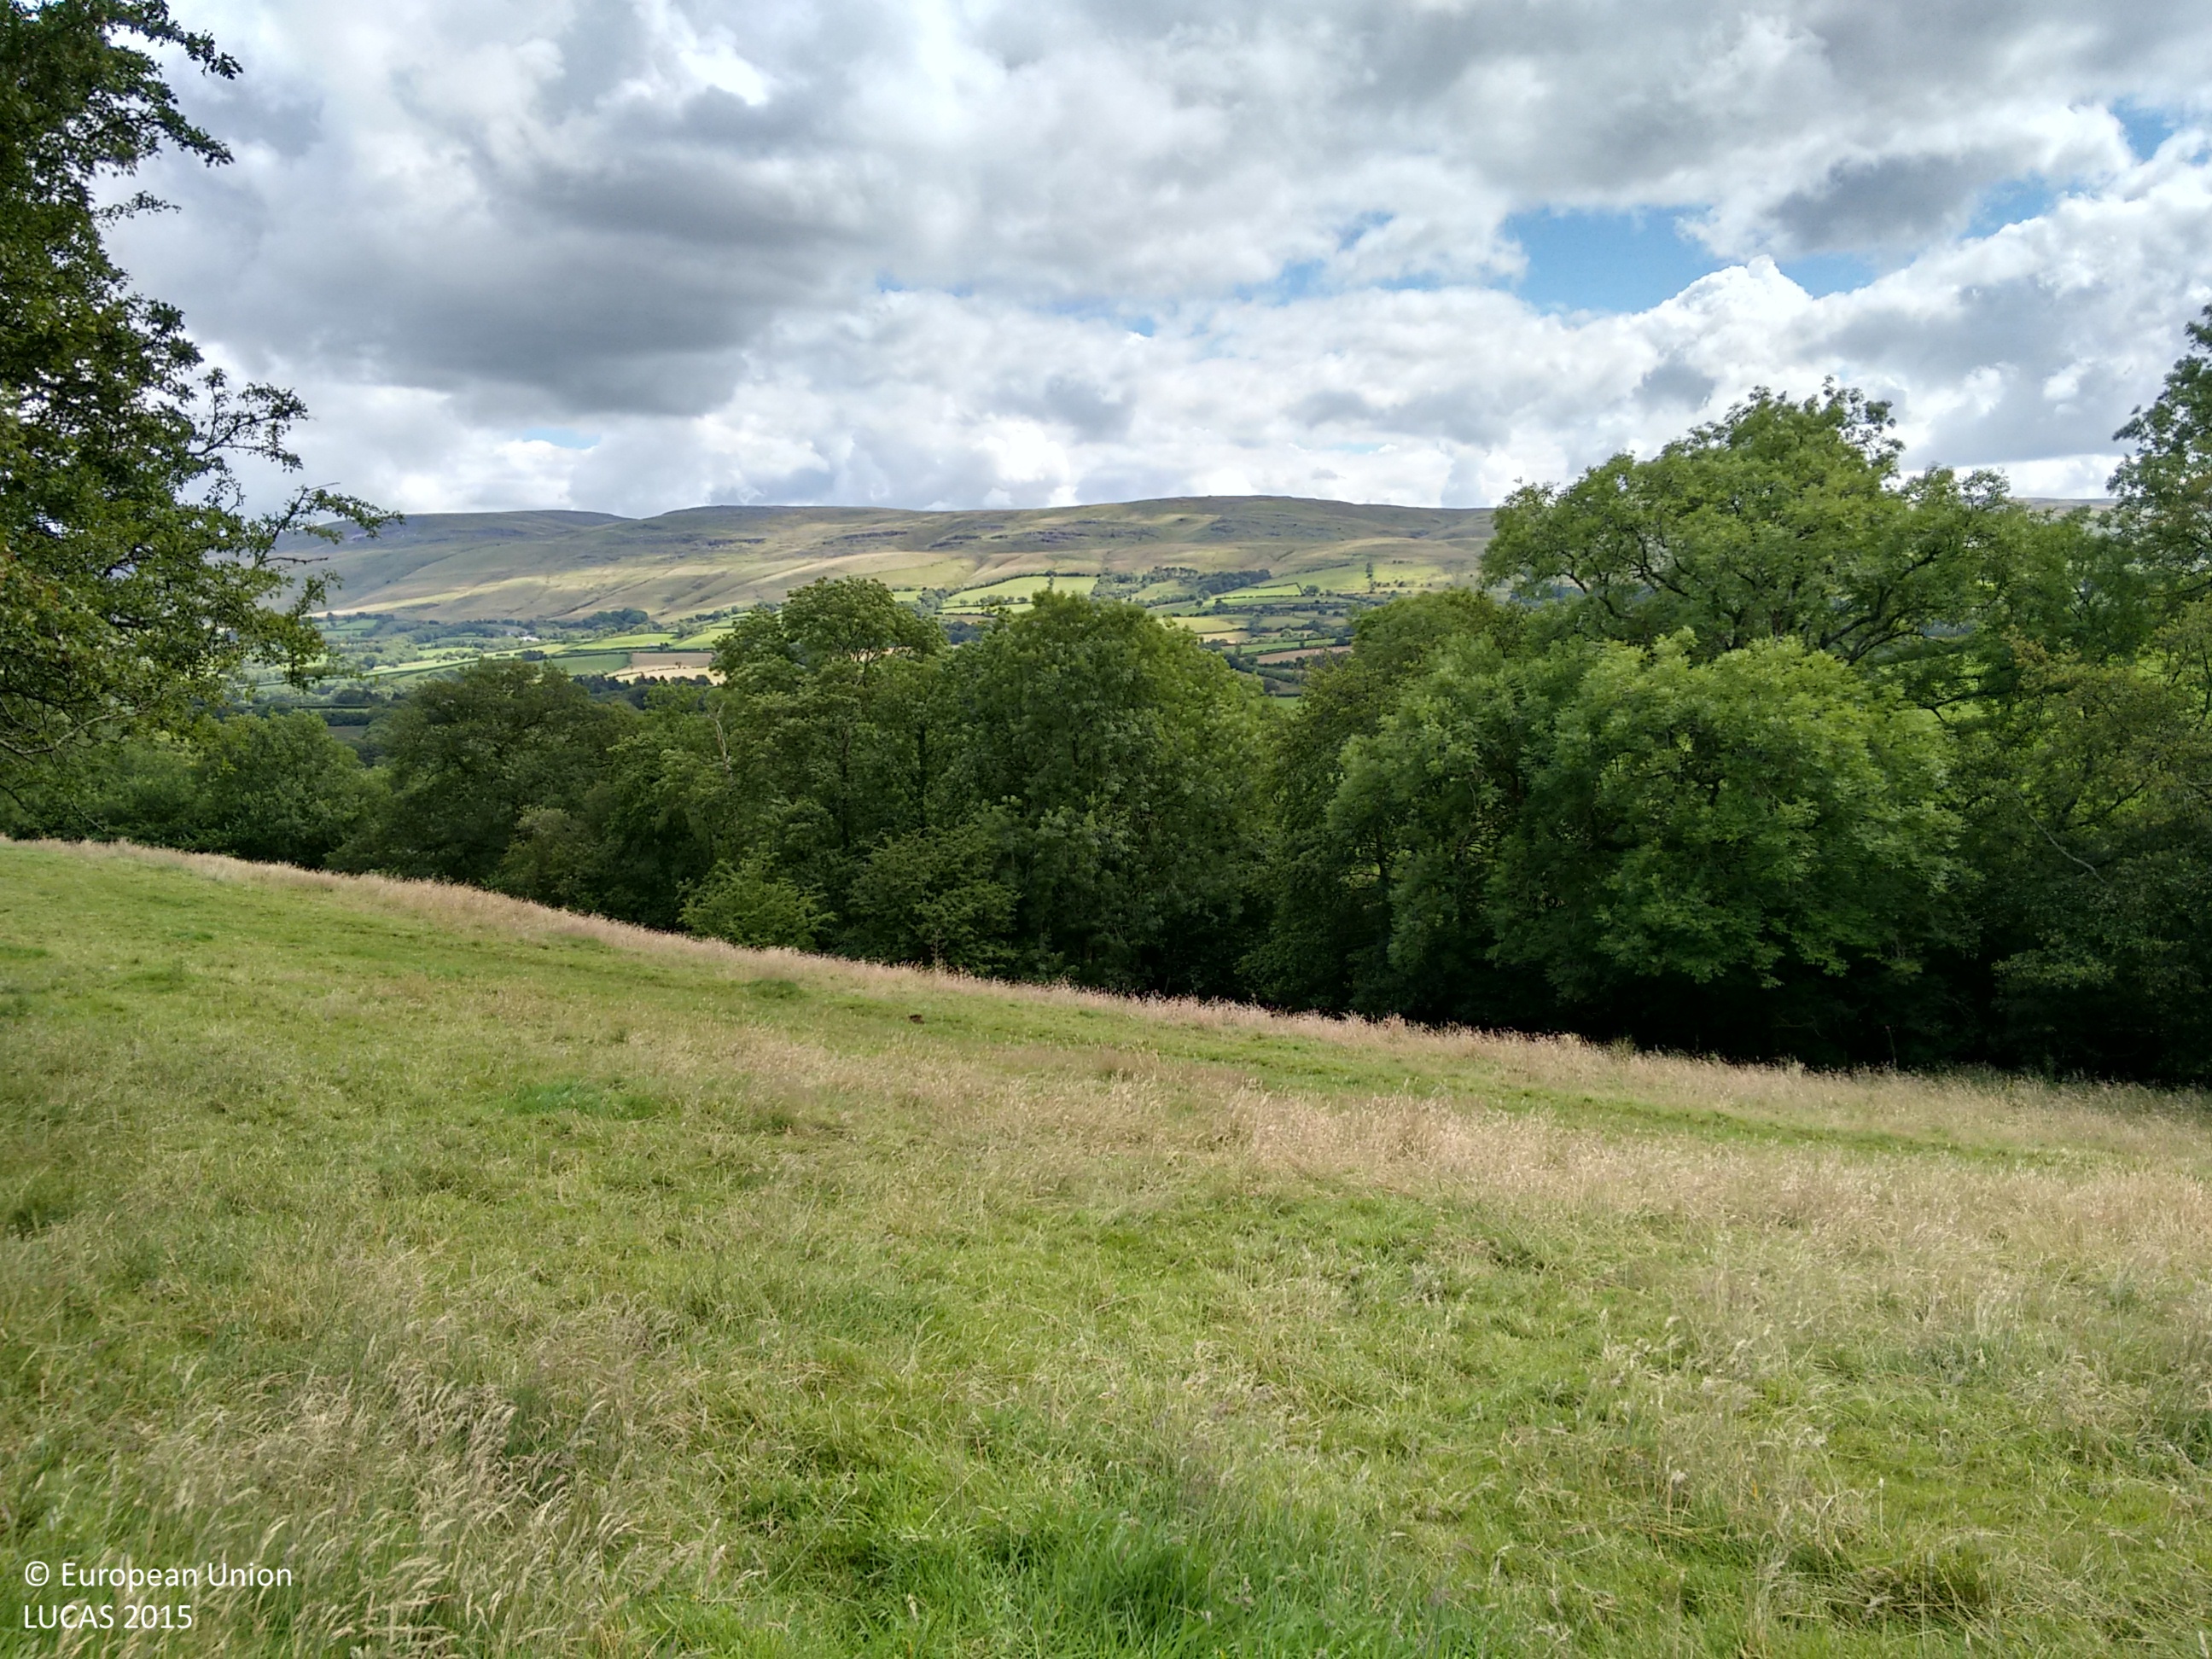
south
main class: Grassland
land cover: Grassland without tree/shrub cover
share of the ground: > 75 %
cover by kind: herbaceous plants 100 %
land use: Agriculture (excluding fallow land and kitchen gardens)
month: July
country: GB
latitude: 51.8854
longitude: -3.8798
